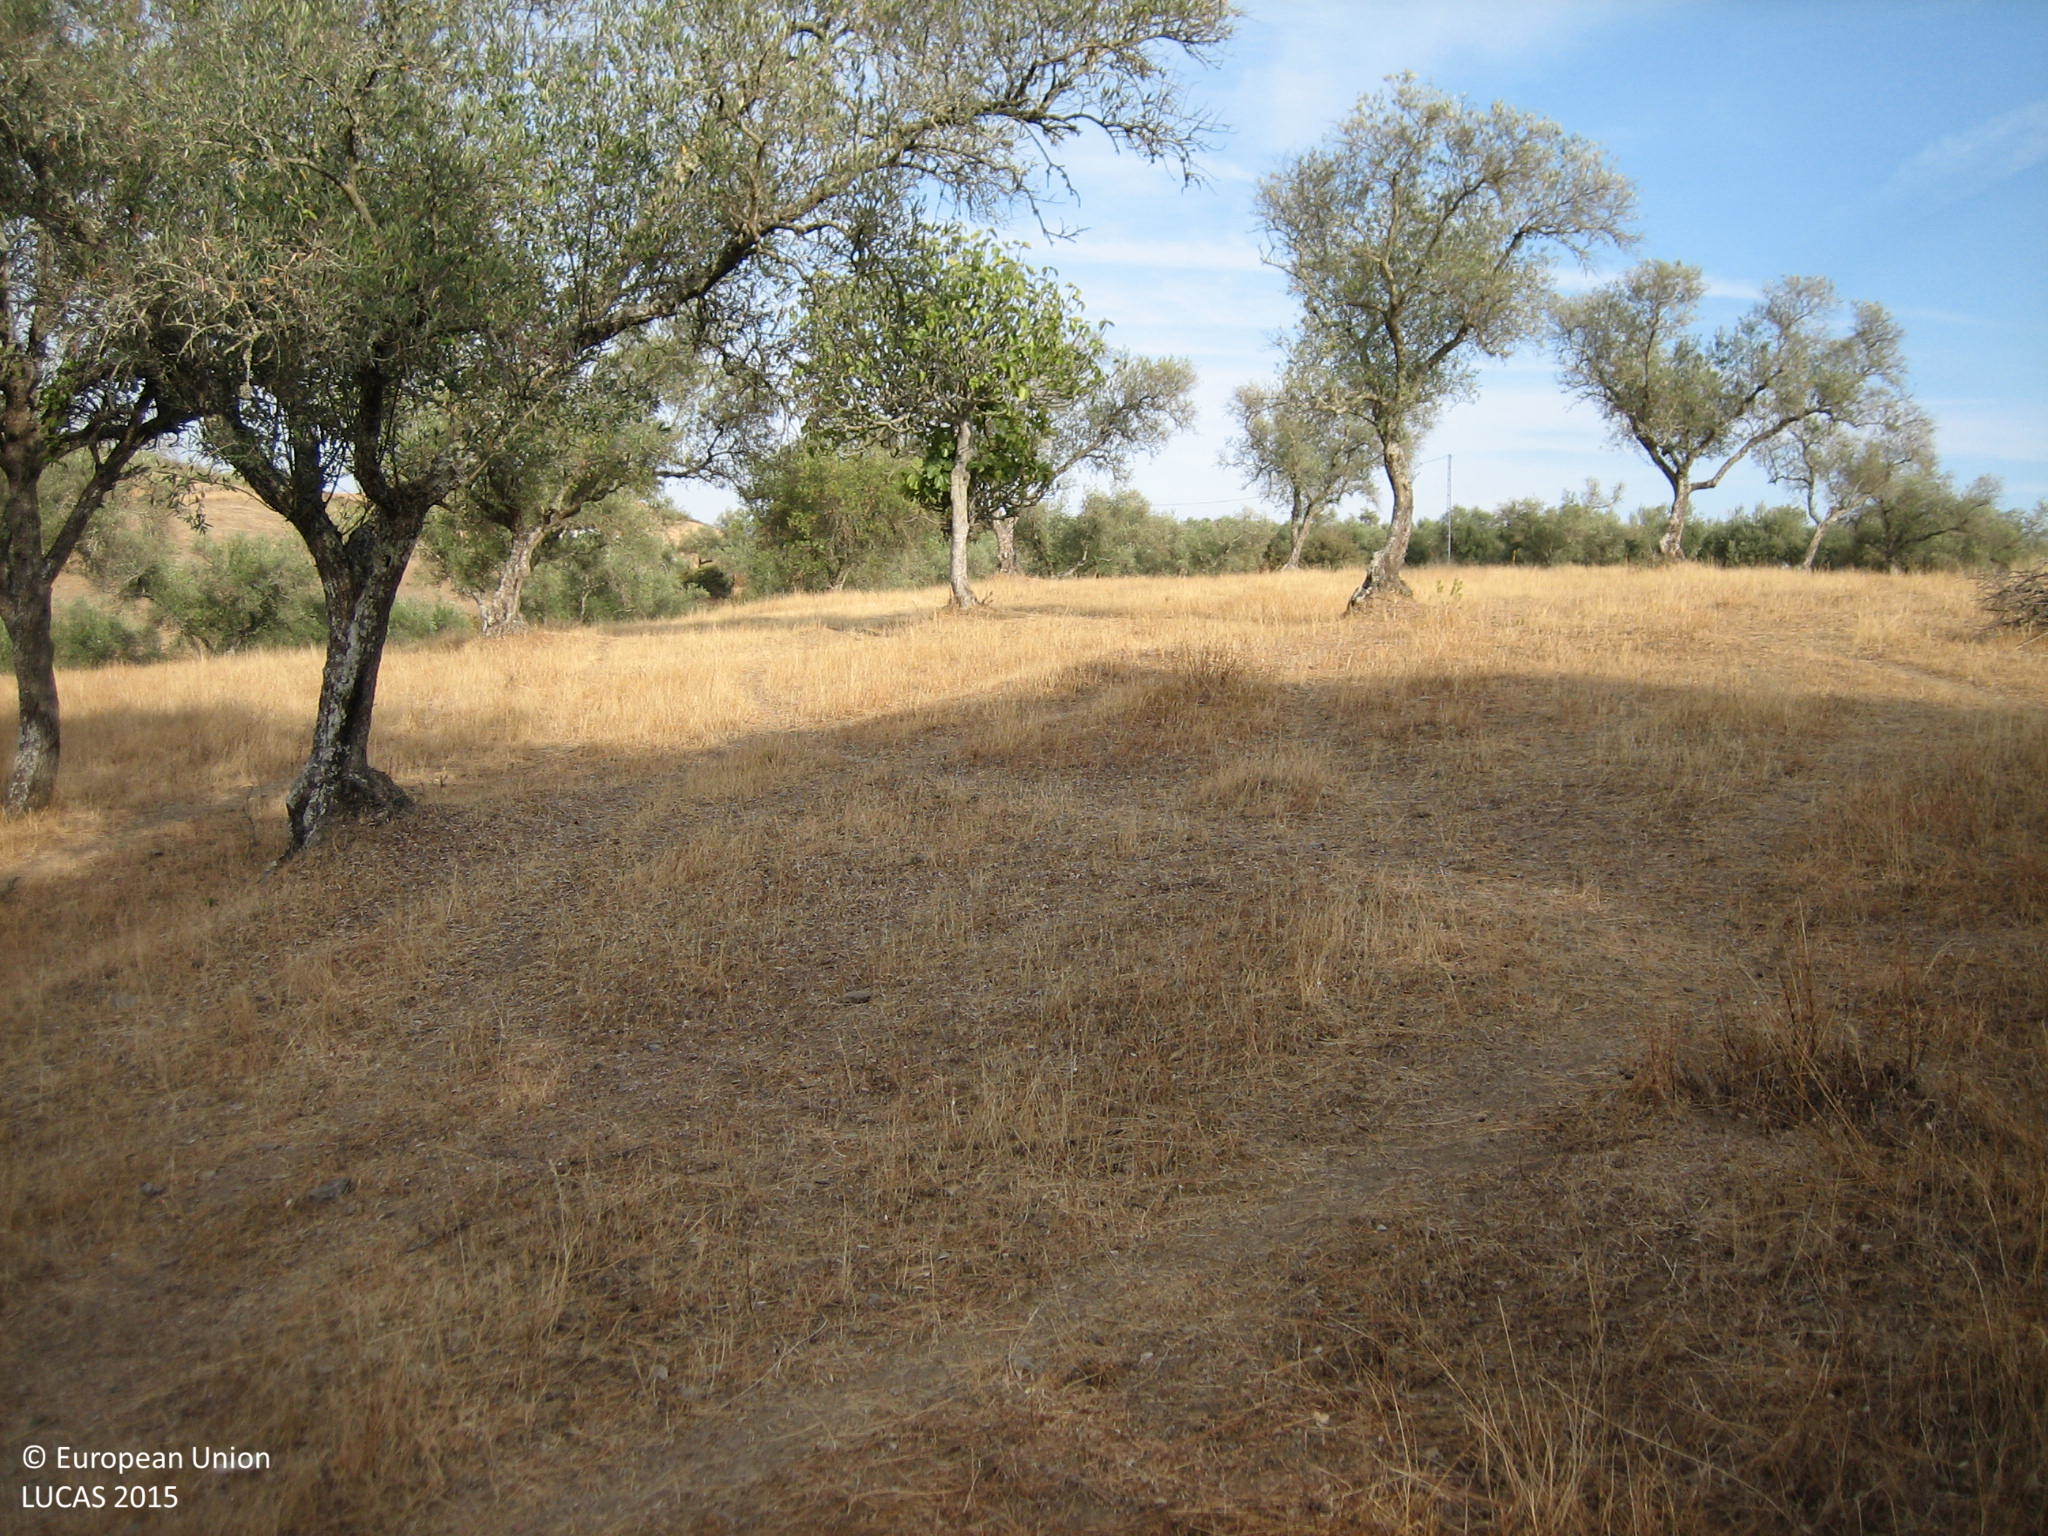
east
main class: Cropland
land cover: Olive groves
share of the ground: 10 - 25 %
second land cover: Grassland without tree/shrub cover
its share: > 75 %
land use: Agriculture (excluding fallow land and kitchen gardens)
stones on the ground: < 10 %
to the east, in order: Olive groves; Grassland without tree/shrub cover; Dry stone walls; Shruby margins; Grass margins; Paved roads, cycling and walking lanes; Grass margins; Shruby margins; Dry stone walls; Grassland without tree/shrub cover; Fences; Grassland without tree/shrub cover; Dry stone walls; Grass margins; Tracks; Grassland without tree/shrub cover; Paved roads, cycling and walking lanes; Electric lines; Grass margins; Artificial constructions in urban areas
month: September
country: ES
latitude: 38.3112
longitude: -6.7872
